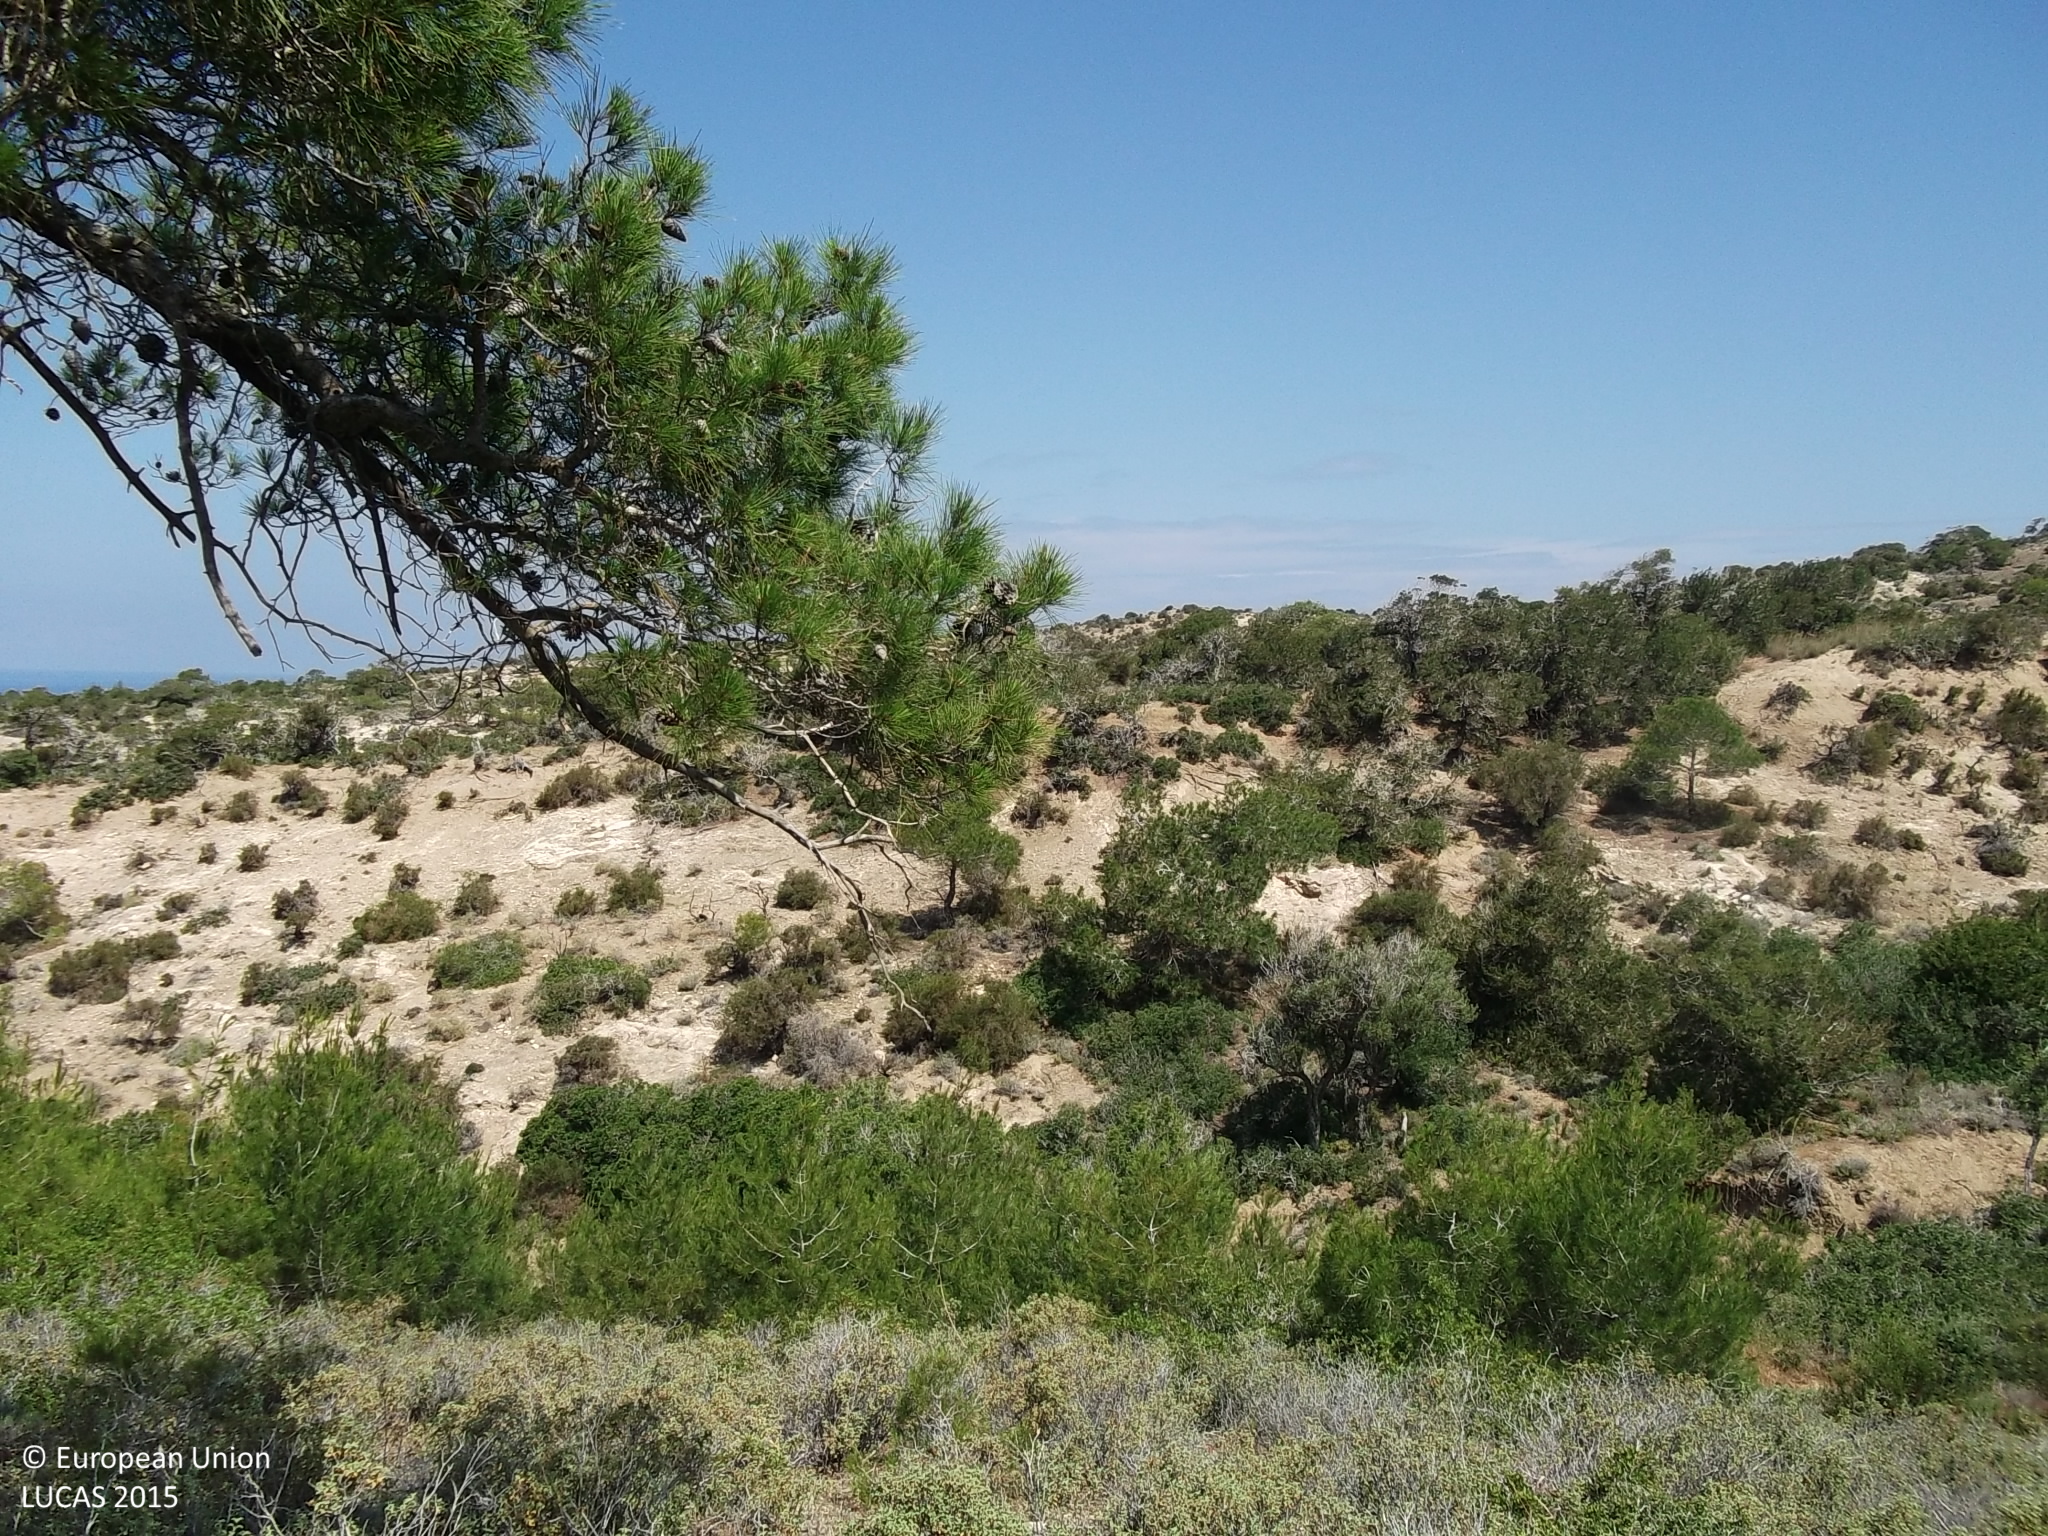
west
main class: Shrubland
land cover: Shrubland with sparse tree cover
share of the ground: > 75 %
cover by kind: shrubs 85 %, unconsolidated bare surface 10 %, broadleaved forest trees 5 %
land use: Agriculture (excluding fallow land and kitchen gardens)
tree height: < 5 m
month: May
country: CY
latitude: 35.0663
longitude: 32.2889
